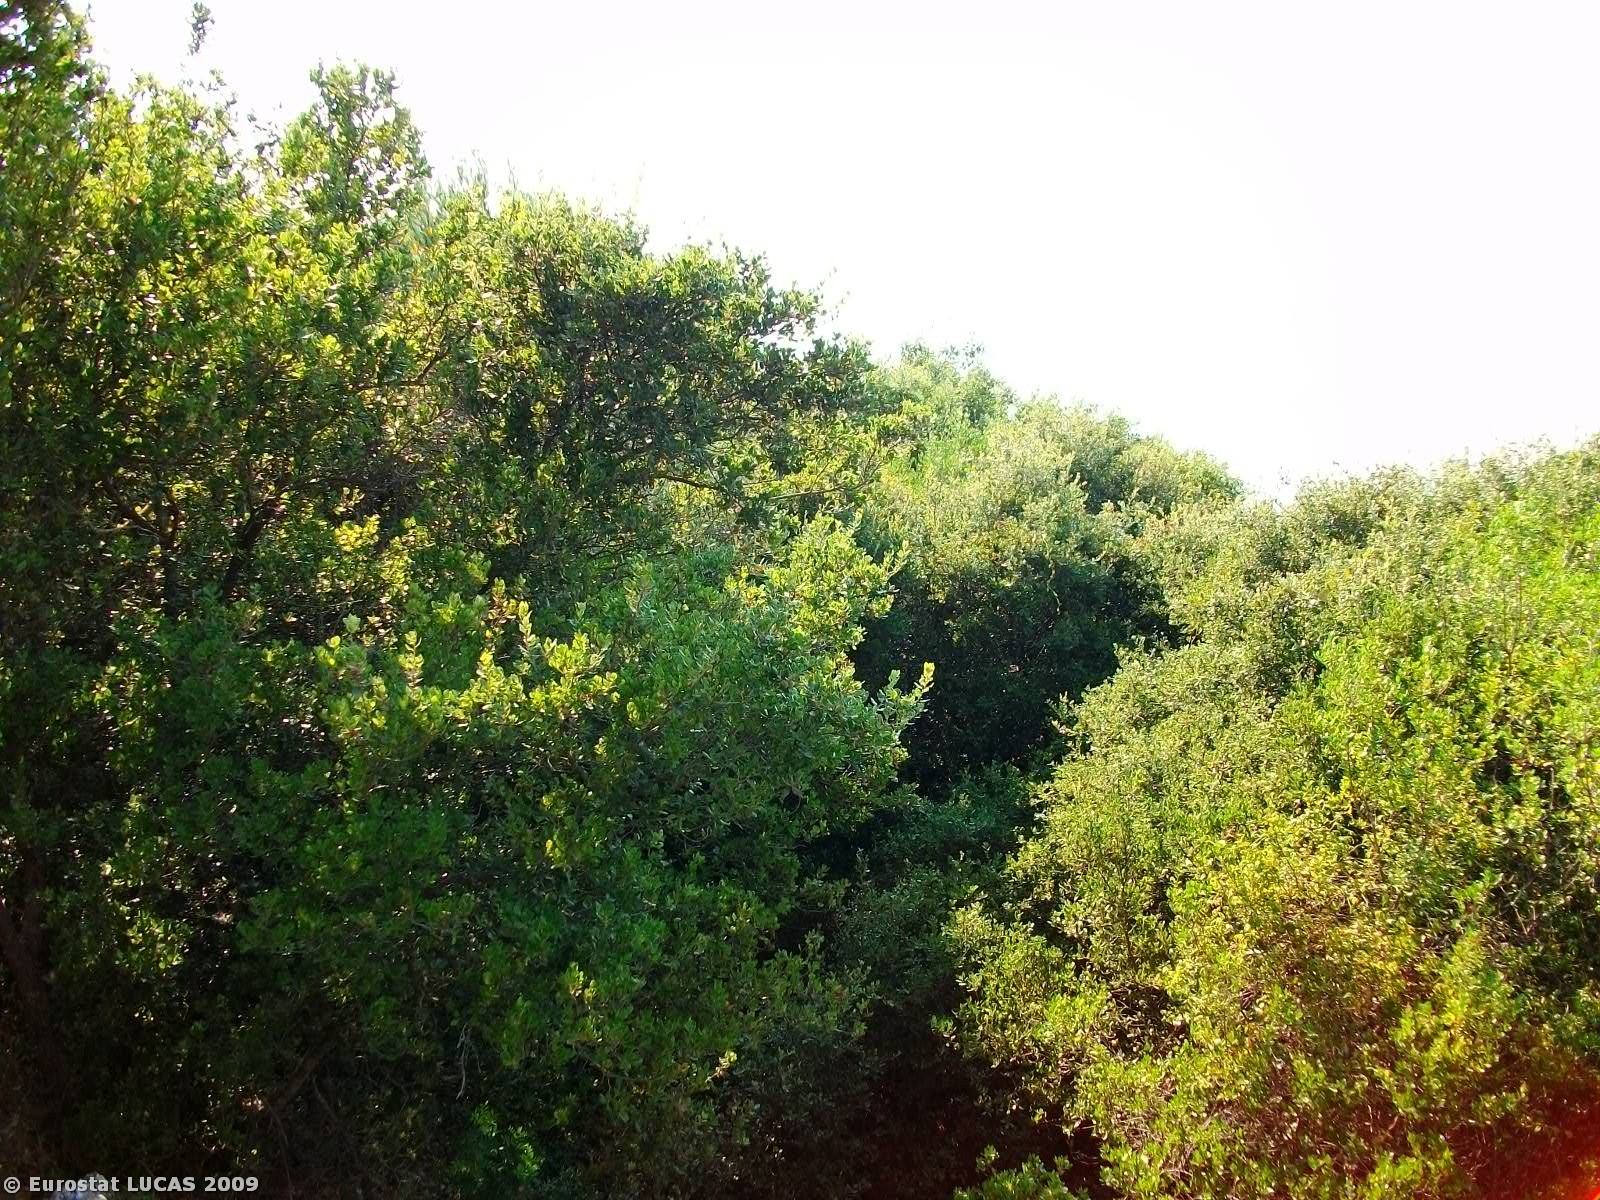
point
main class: Woodland
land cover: Broadleaved woodland
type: broadleaved evergreen forest
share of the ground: > 75 %
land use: Forestry
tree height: > 5 m
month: August
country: GR
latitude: 39.5647
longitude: 20.2523
